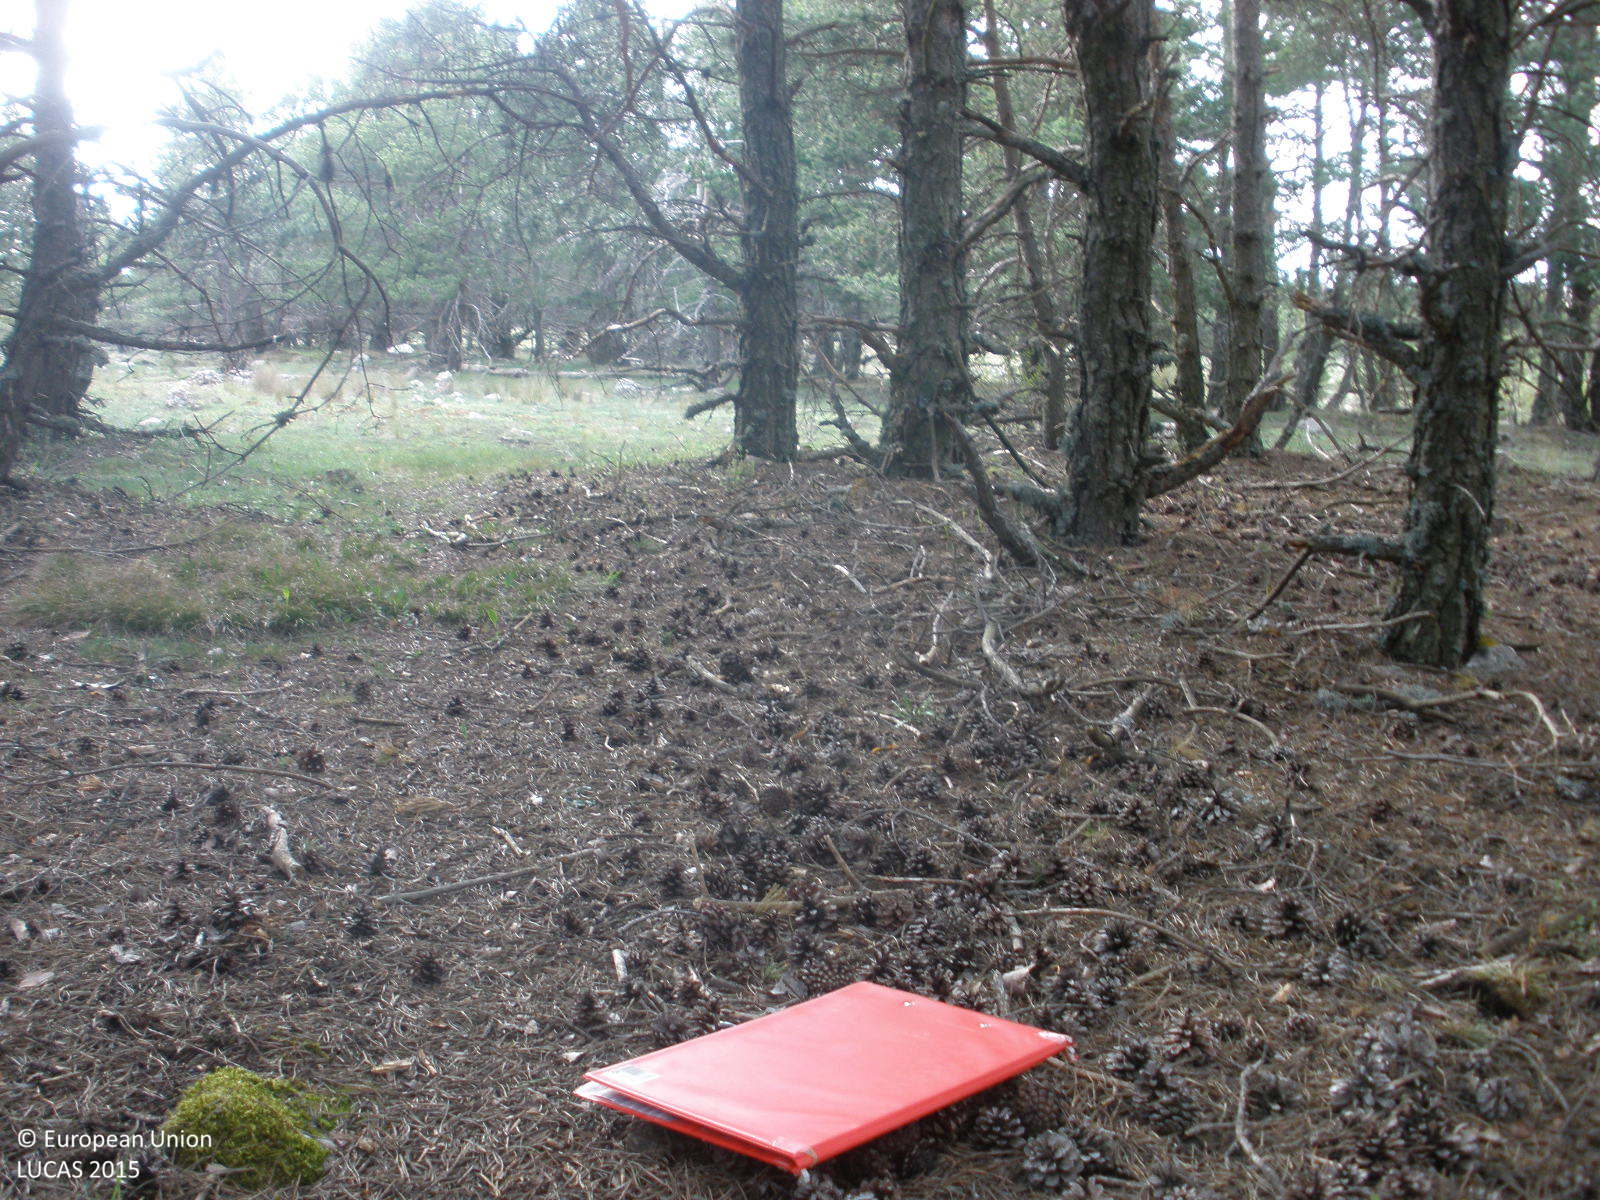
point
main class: Woodland
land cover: Pine dominated coniferous woodland
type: coniferous forest of the mediterranean region
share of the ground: > 75 %
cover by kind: coniferous forest trees 90 %, herbaceous plants 10 %
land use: Forestry
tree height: > 5 m
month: May
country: ES
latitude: 40.5762
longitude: -0.8439
